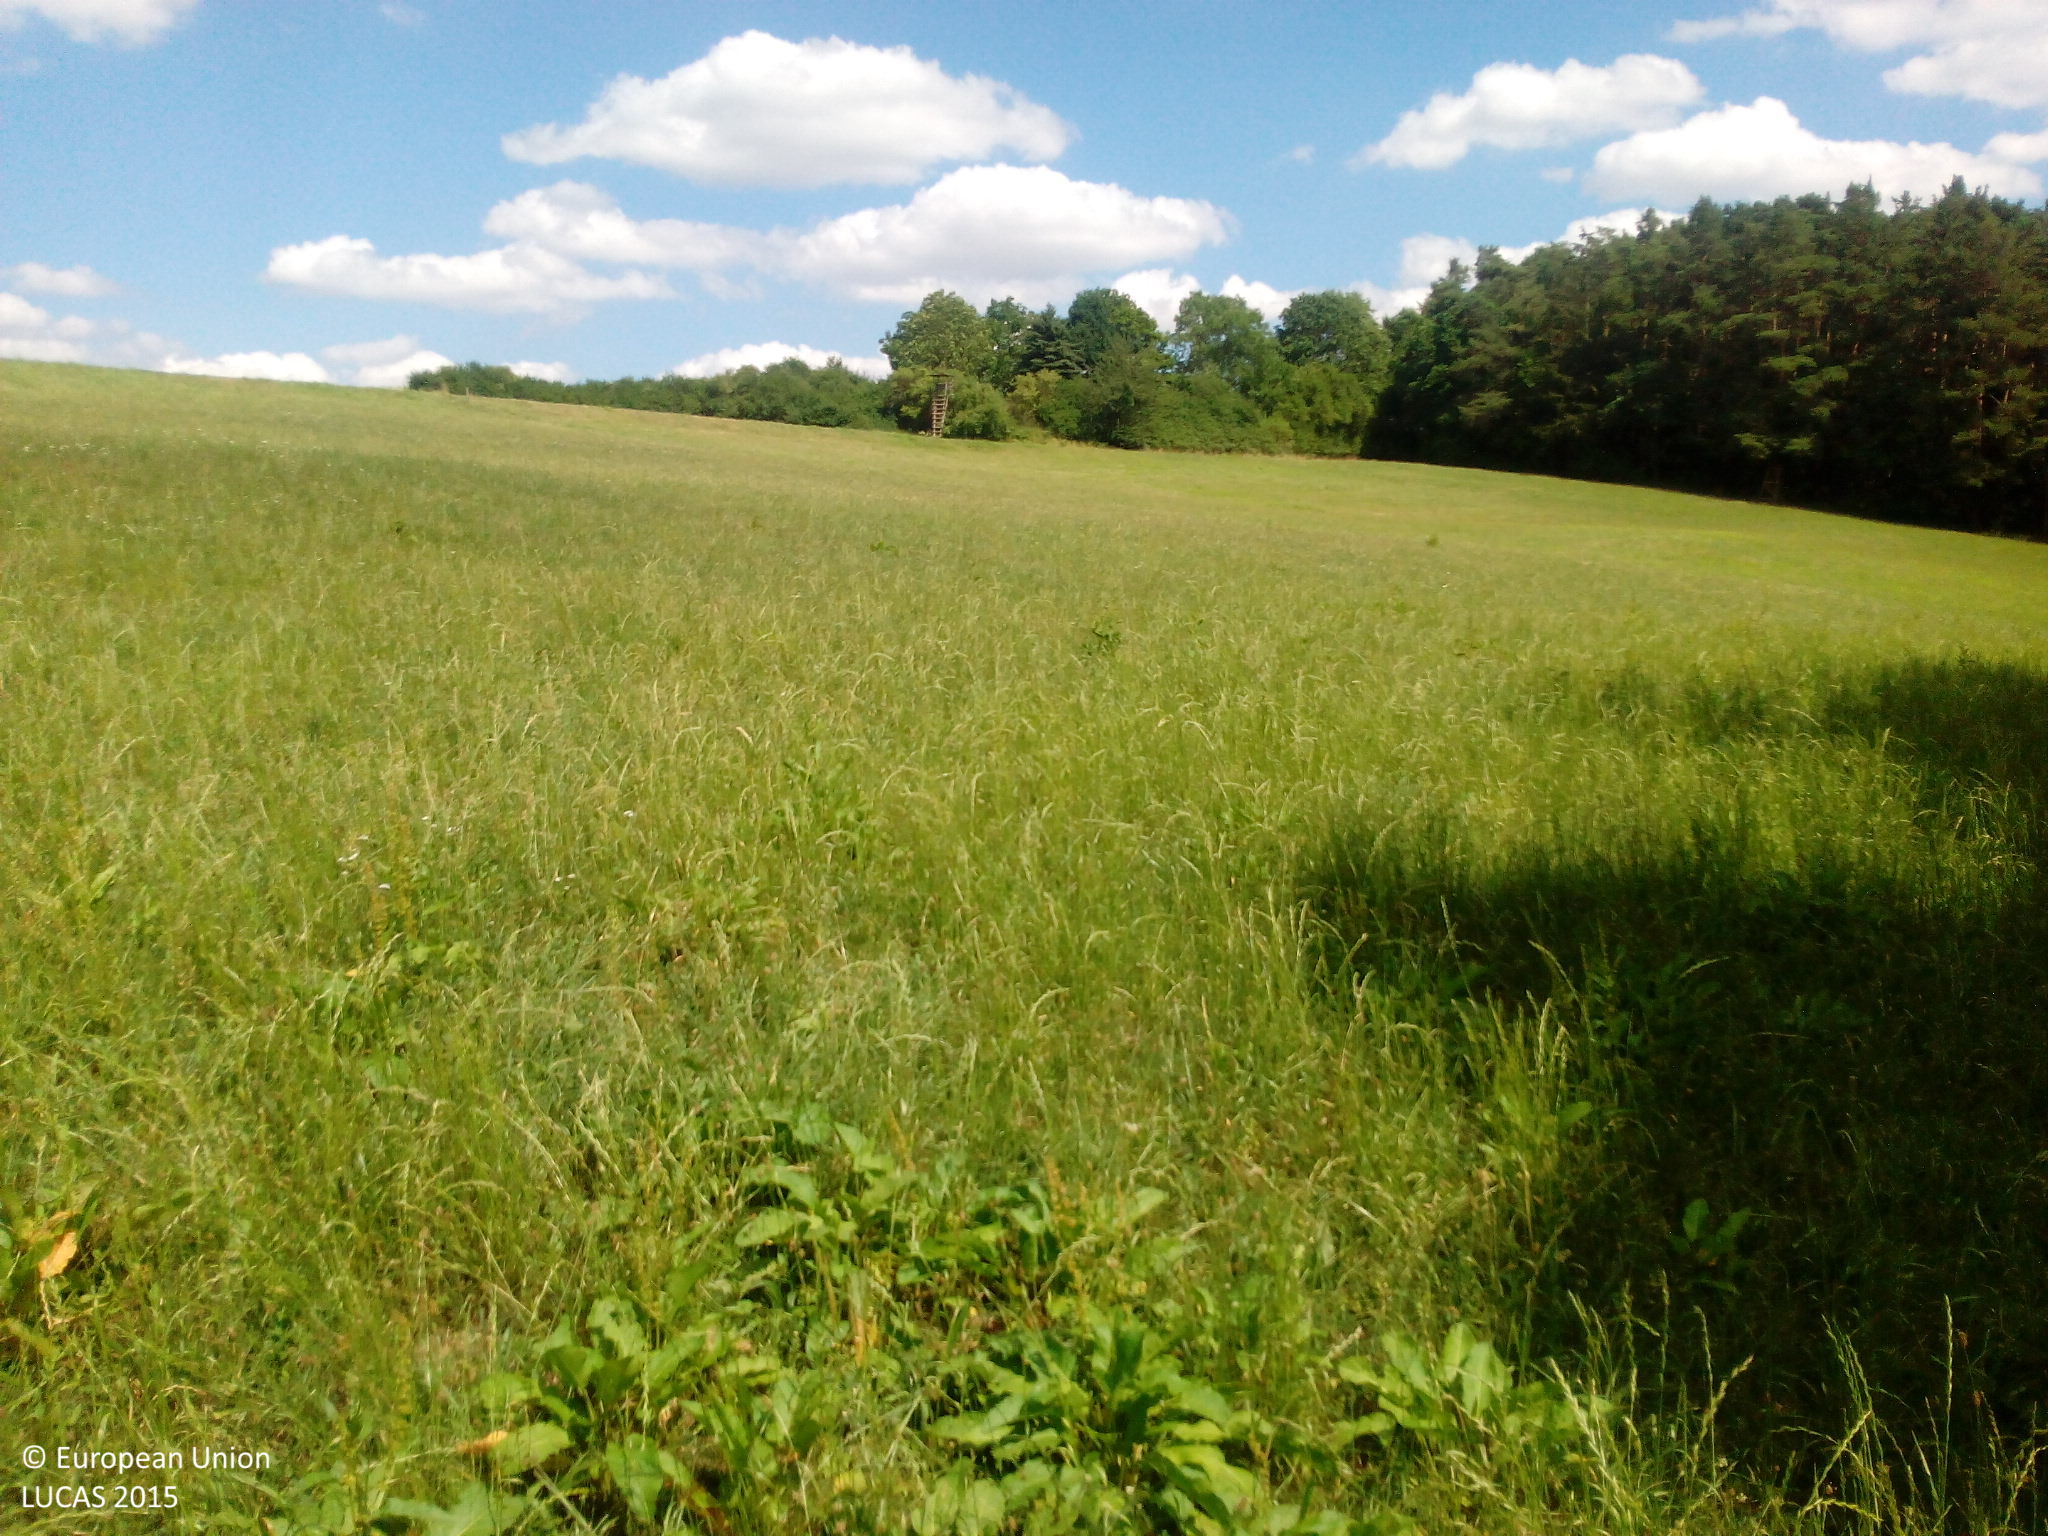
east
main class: Grassland
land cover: Grassland without tree/shrub cover
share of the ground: > 75 %
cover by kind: herbaceous plants 100 %
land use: Agriculture (excluding fallow land and kitchen gardens)
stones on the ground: < 10 %
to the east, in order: Grassland without tree/shrub cover; Tracks; Broadleaved woodland; Fences; Grassland without tree/shrub cover; Fences; Grass margins; Maize
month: July
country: DE
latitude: 49.4433
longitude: 10.8962
